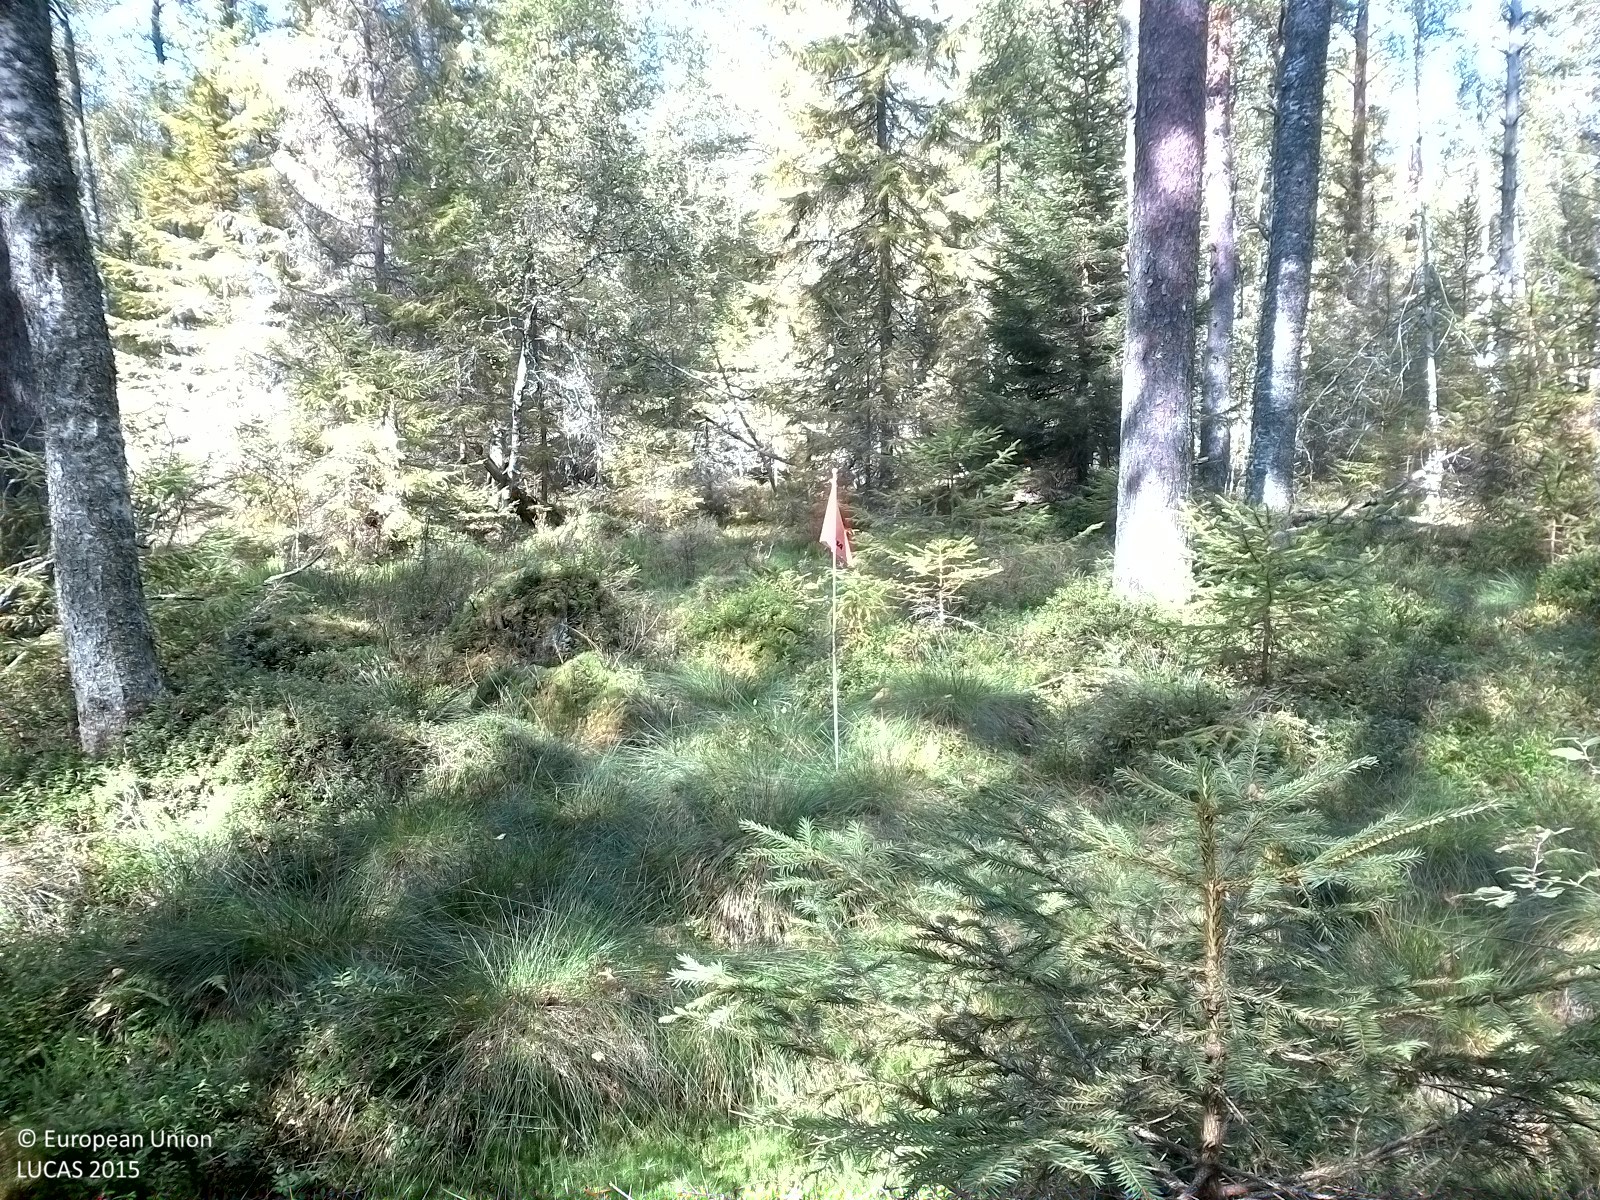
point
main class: Woodland
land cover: Other mixed woodland
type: boreal forest
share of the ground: 25 - 50 %
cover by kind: herbaceous plants 40 %, coniferous forest trees 25 %, broadleaved forest trees 15 %, lichens and mosses 15 %, shrubs 5 %
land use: Forestry
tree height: > 5 m
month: August
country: SE
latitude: 59.0758
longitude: 15.6276
